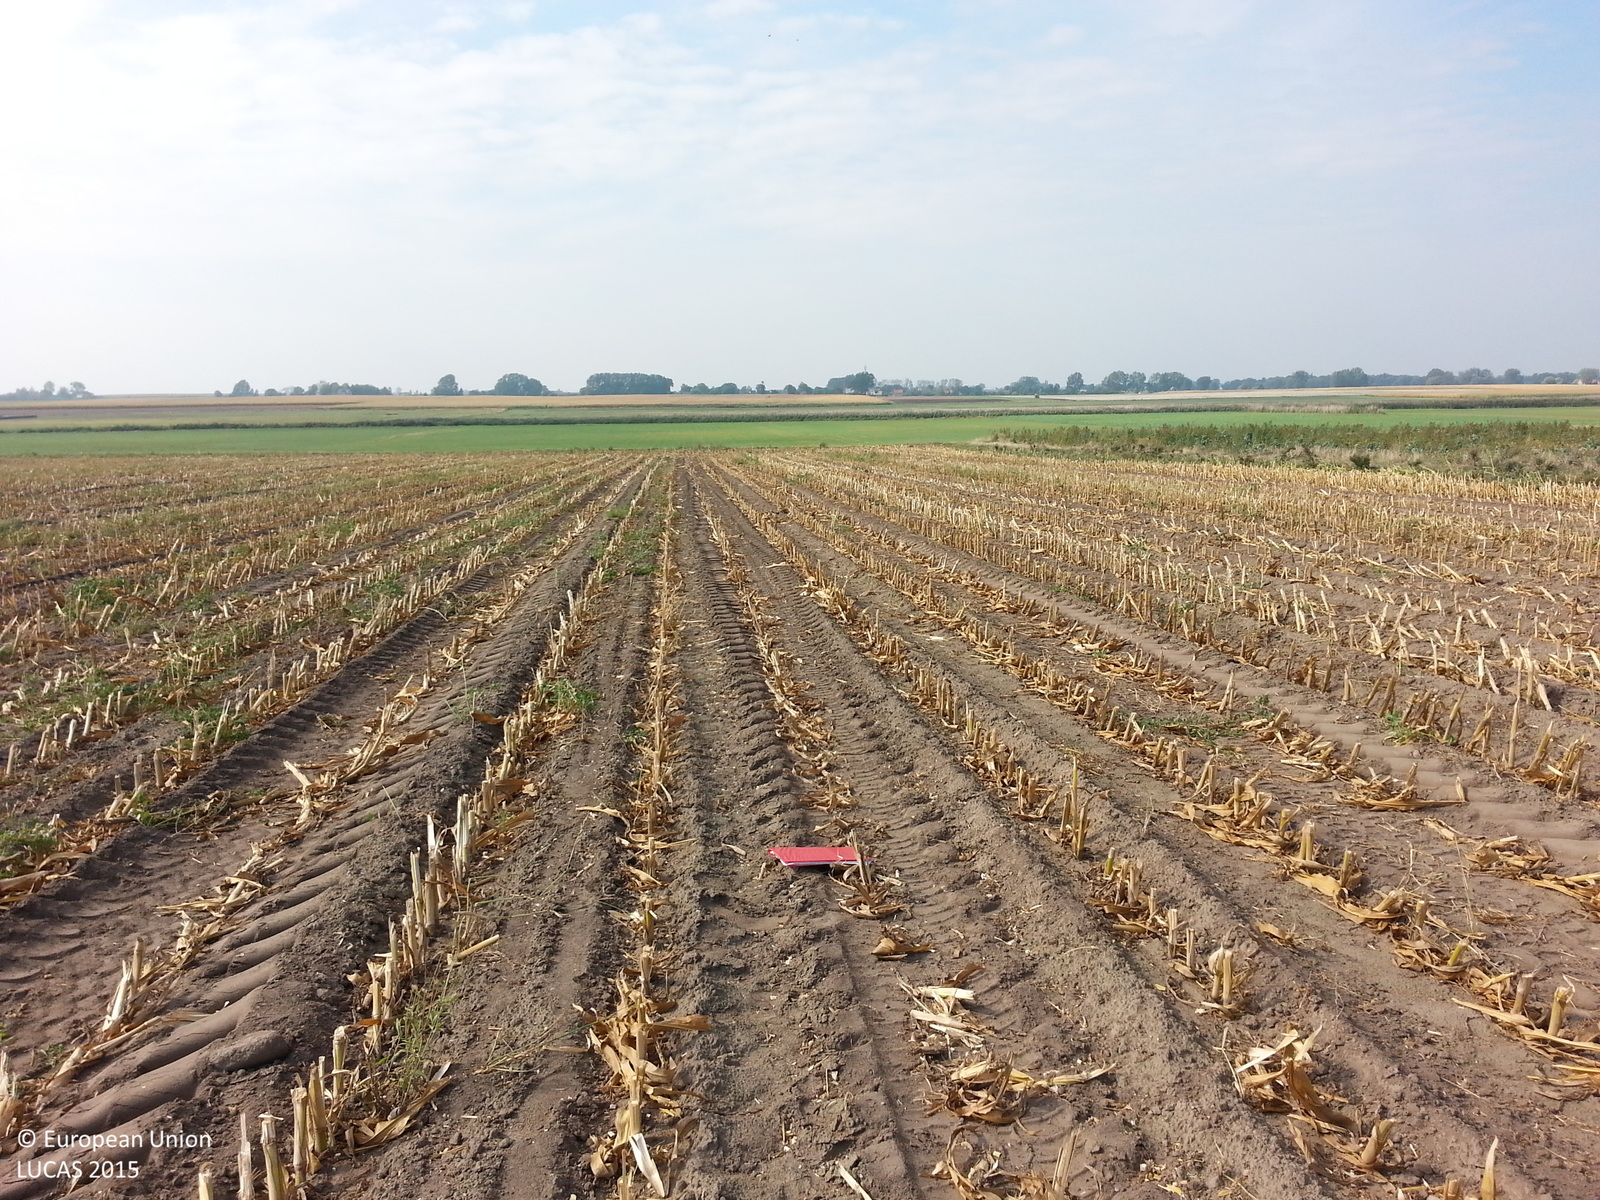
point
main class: Cropland
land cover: Maize
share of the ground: 25 - 50 %
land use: Agriculture (excluding fallow land and kitchen gardens)
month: September
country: PL
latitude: 52.9320
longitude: 18.0942
